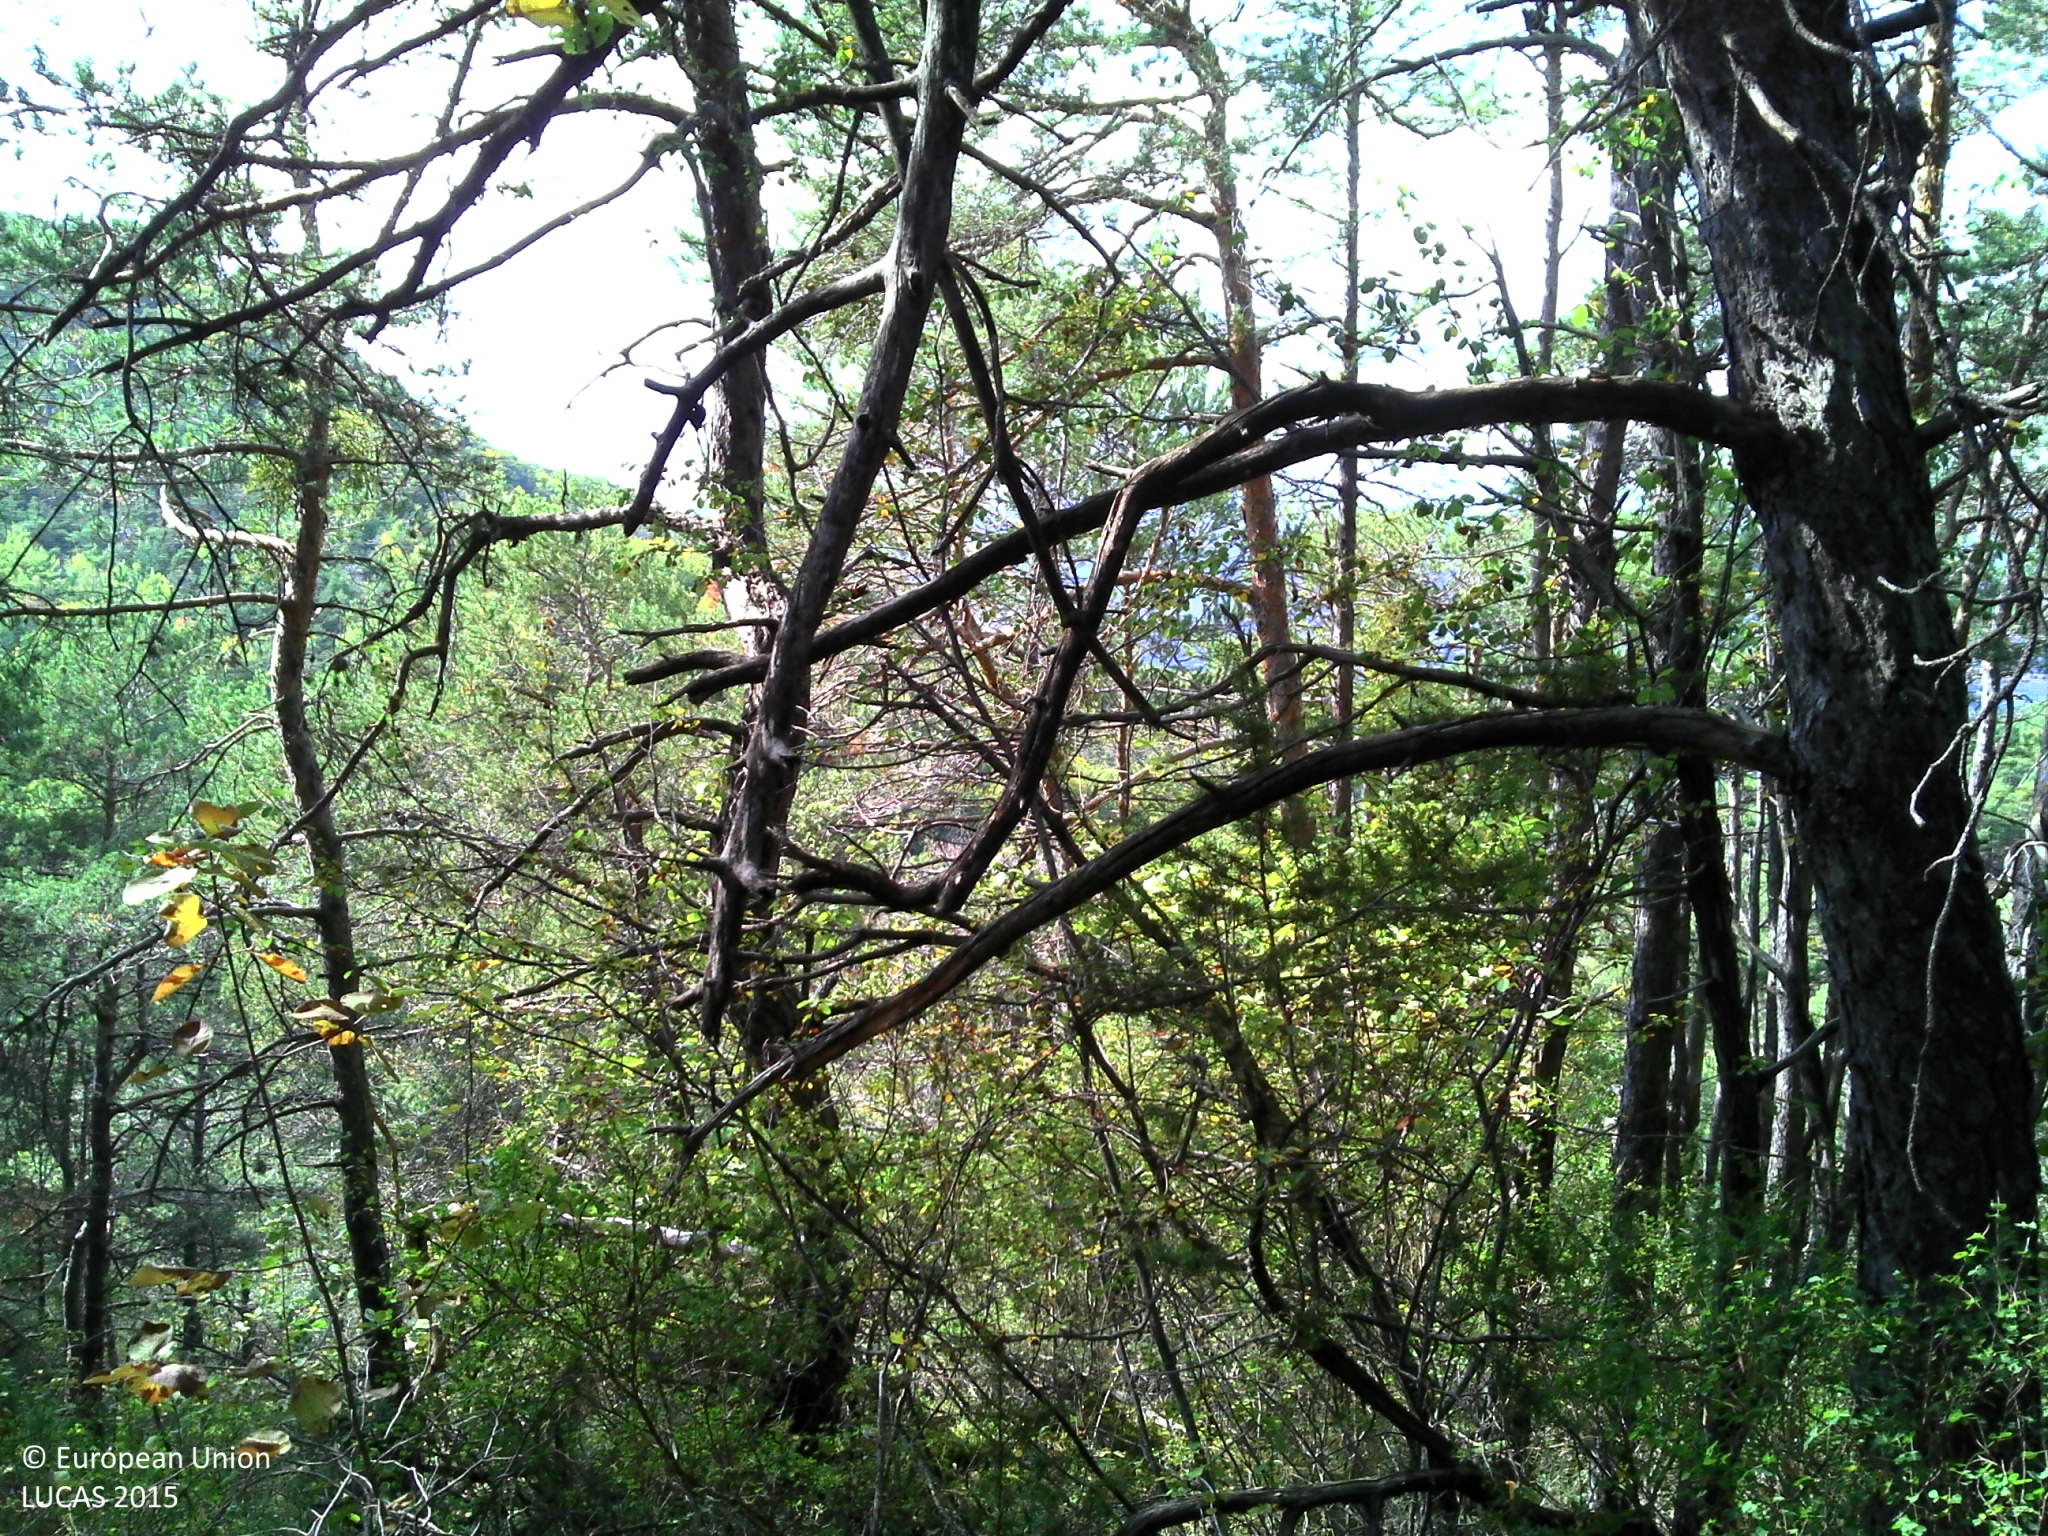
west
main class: Woodland
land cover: Pine dominated coniferous woodland
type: hemiboreal forest and nemoral coniferous forest and mixed broadleaved-coniferous forest
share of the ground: > 75 %
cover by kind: coniferous forest trees 70 %, broadleaved forest trees 10 %, shrubs 10 %, herbaceous plants 5 %, consolidated bare surface 5 %
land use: Forestry
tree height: > 5 m
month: September
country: FR
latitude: 44.5344
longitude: 6.2187
